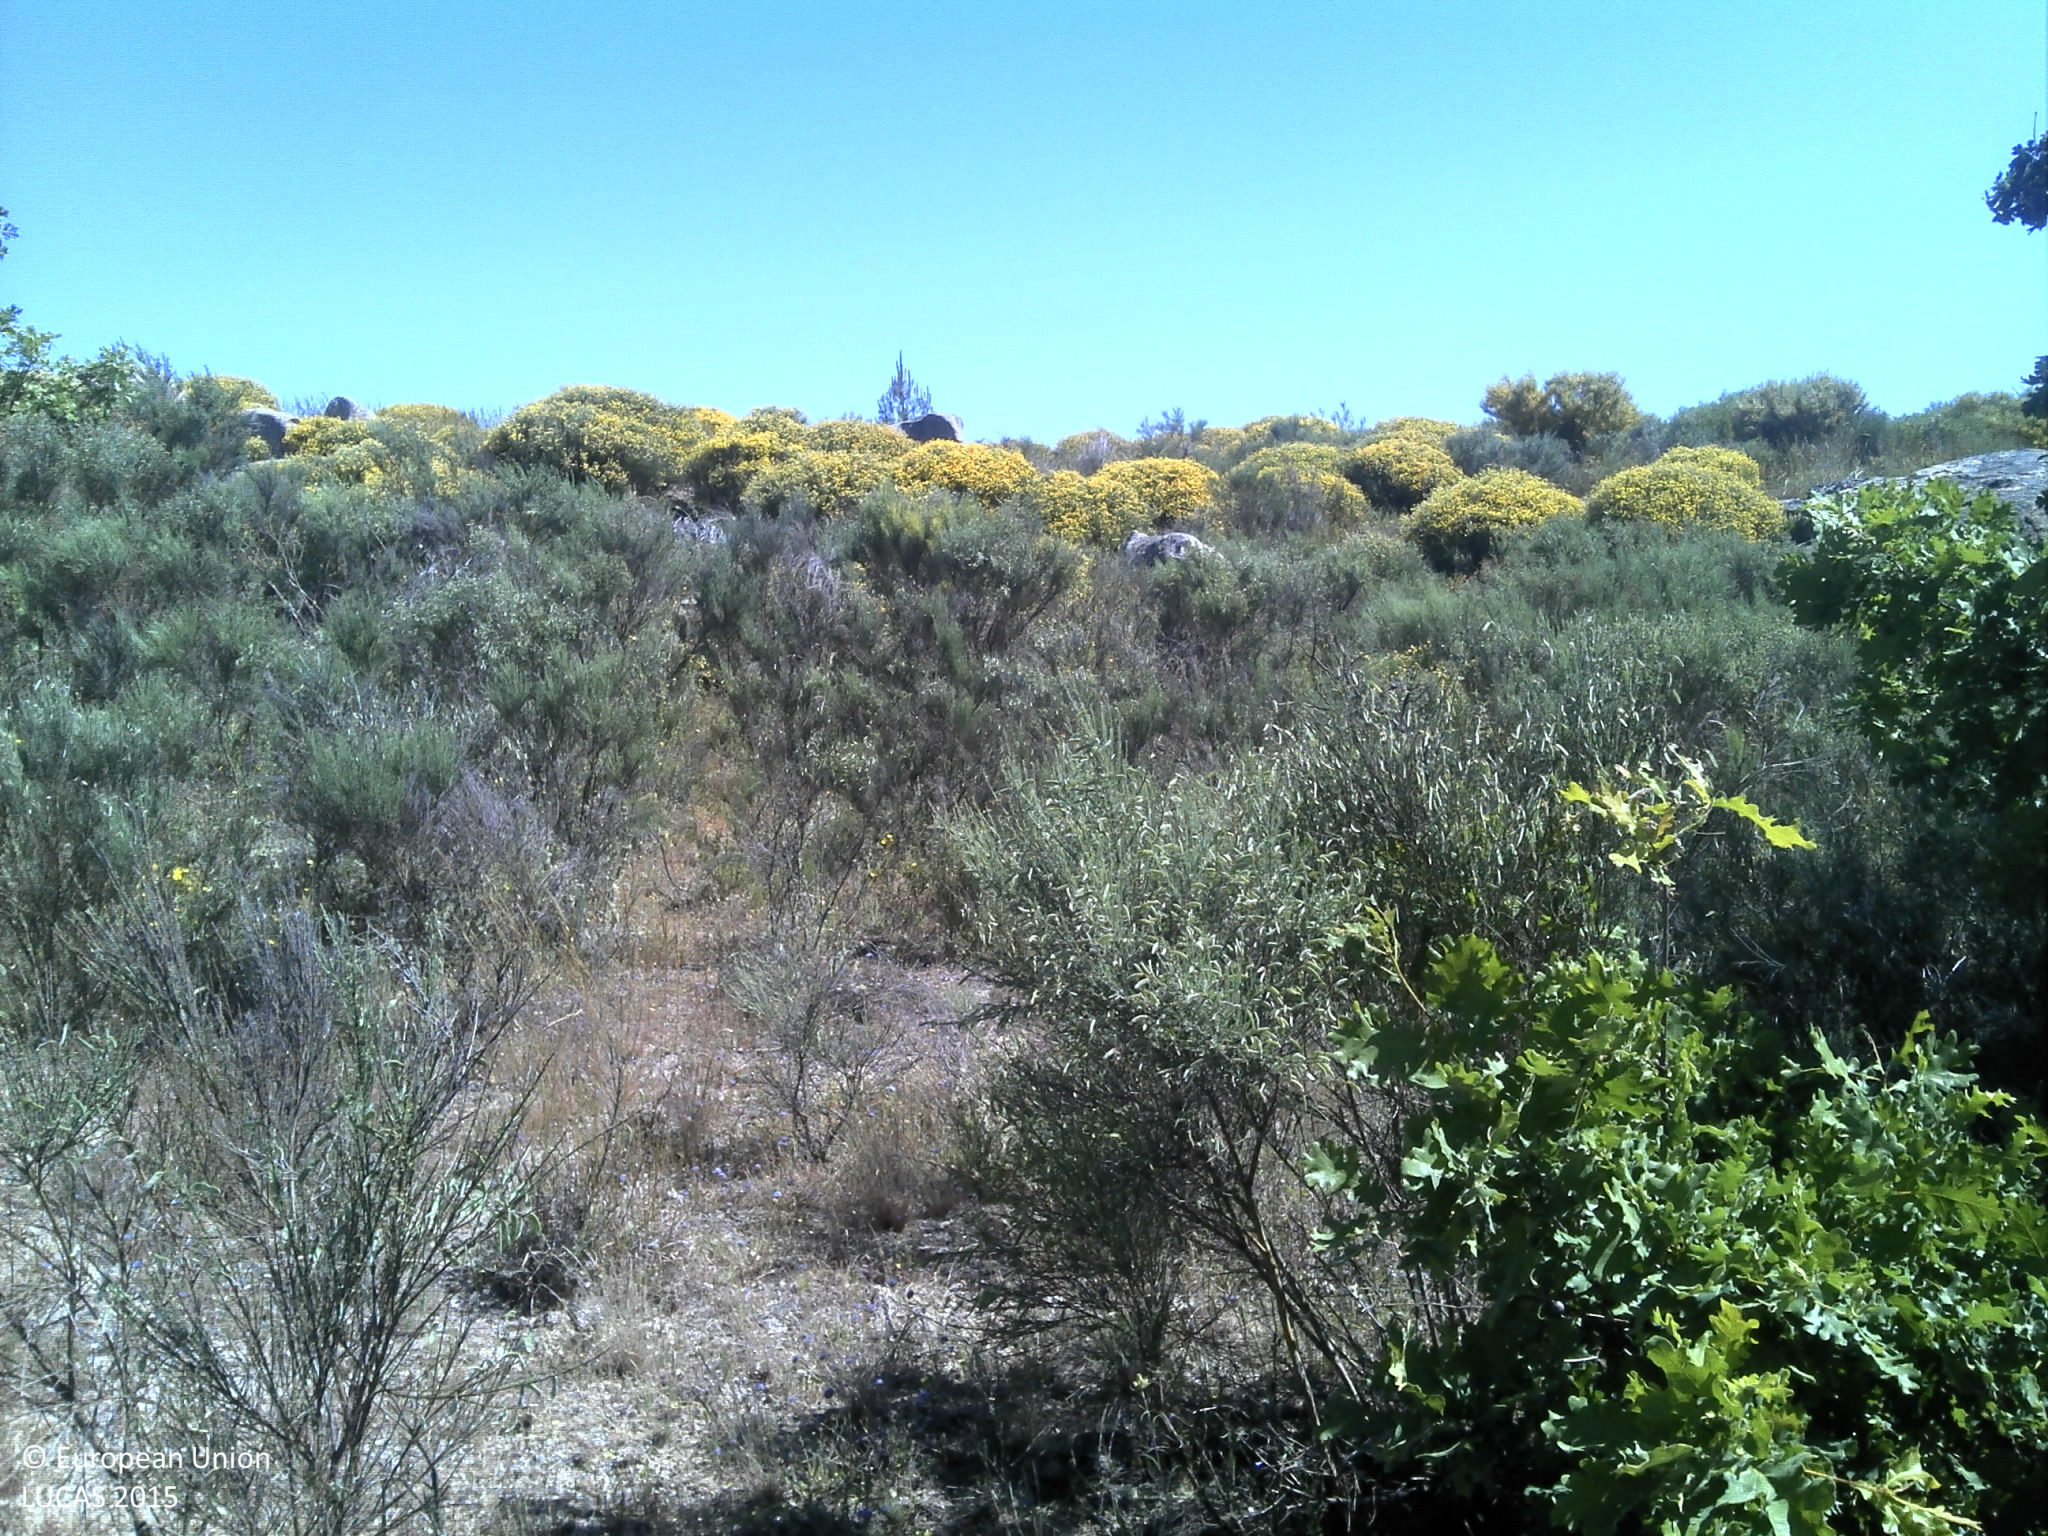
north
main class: Shrubland
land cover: Shrubland with sparse tree cover
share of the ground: 25 - 50 %
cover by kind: shrubs 70 %, unconsolidated bare surface 10 %, broadleaved forest trees 5 %, herbaceous plants 5 %
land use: Semi-natural and natural areas not in use
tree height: < 5 m
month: May
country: PT
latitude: 40.6138
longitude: -7.1120
